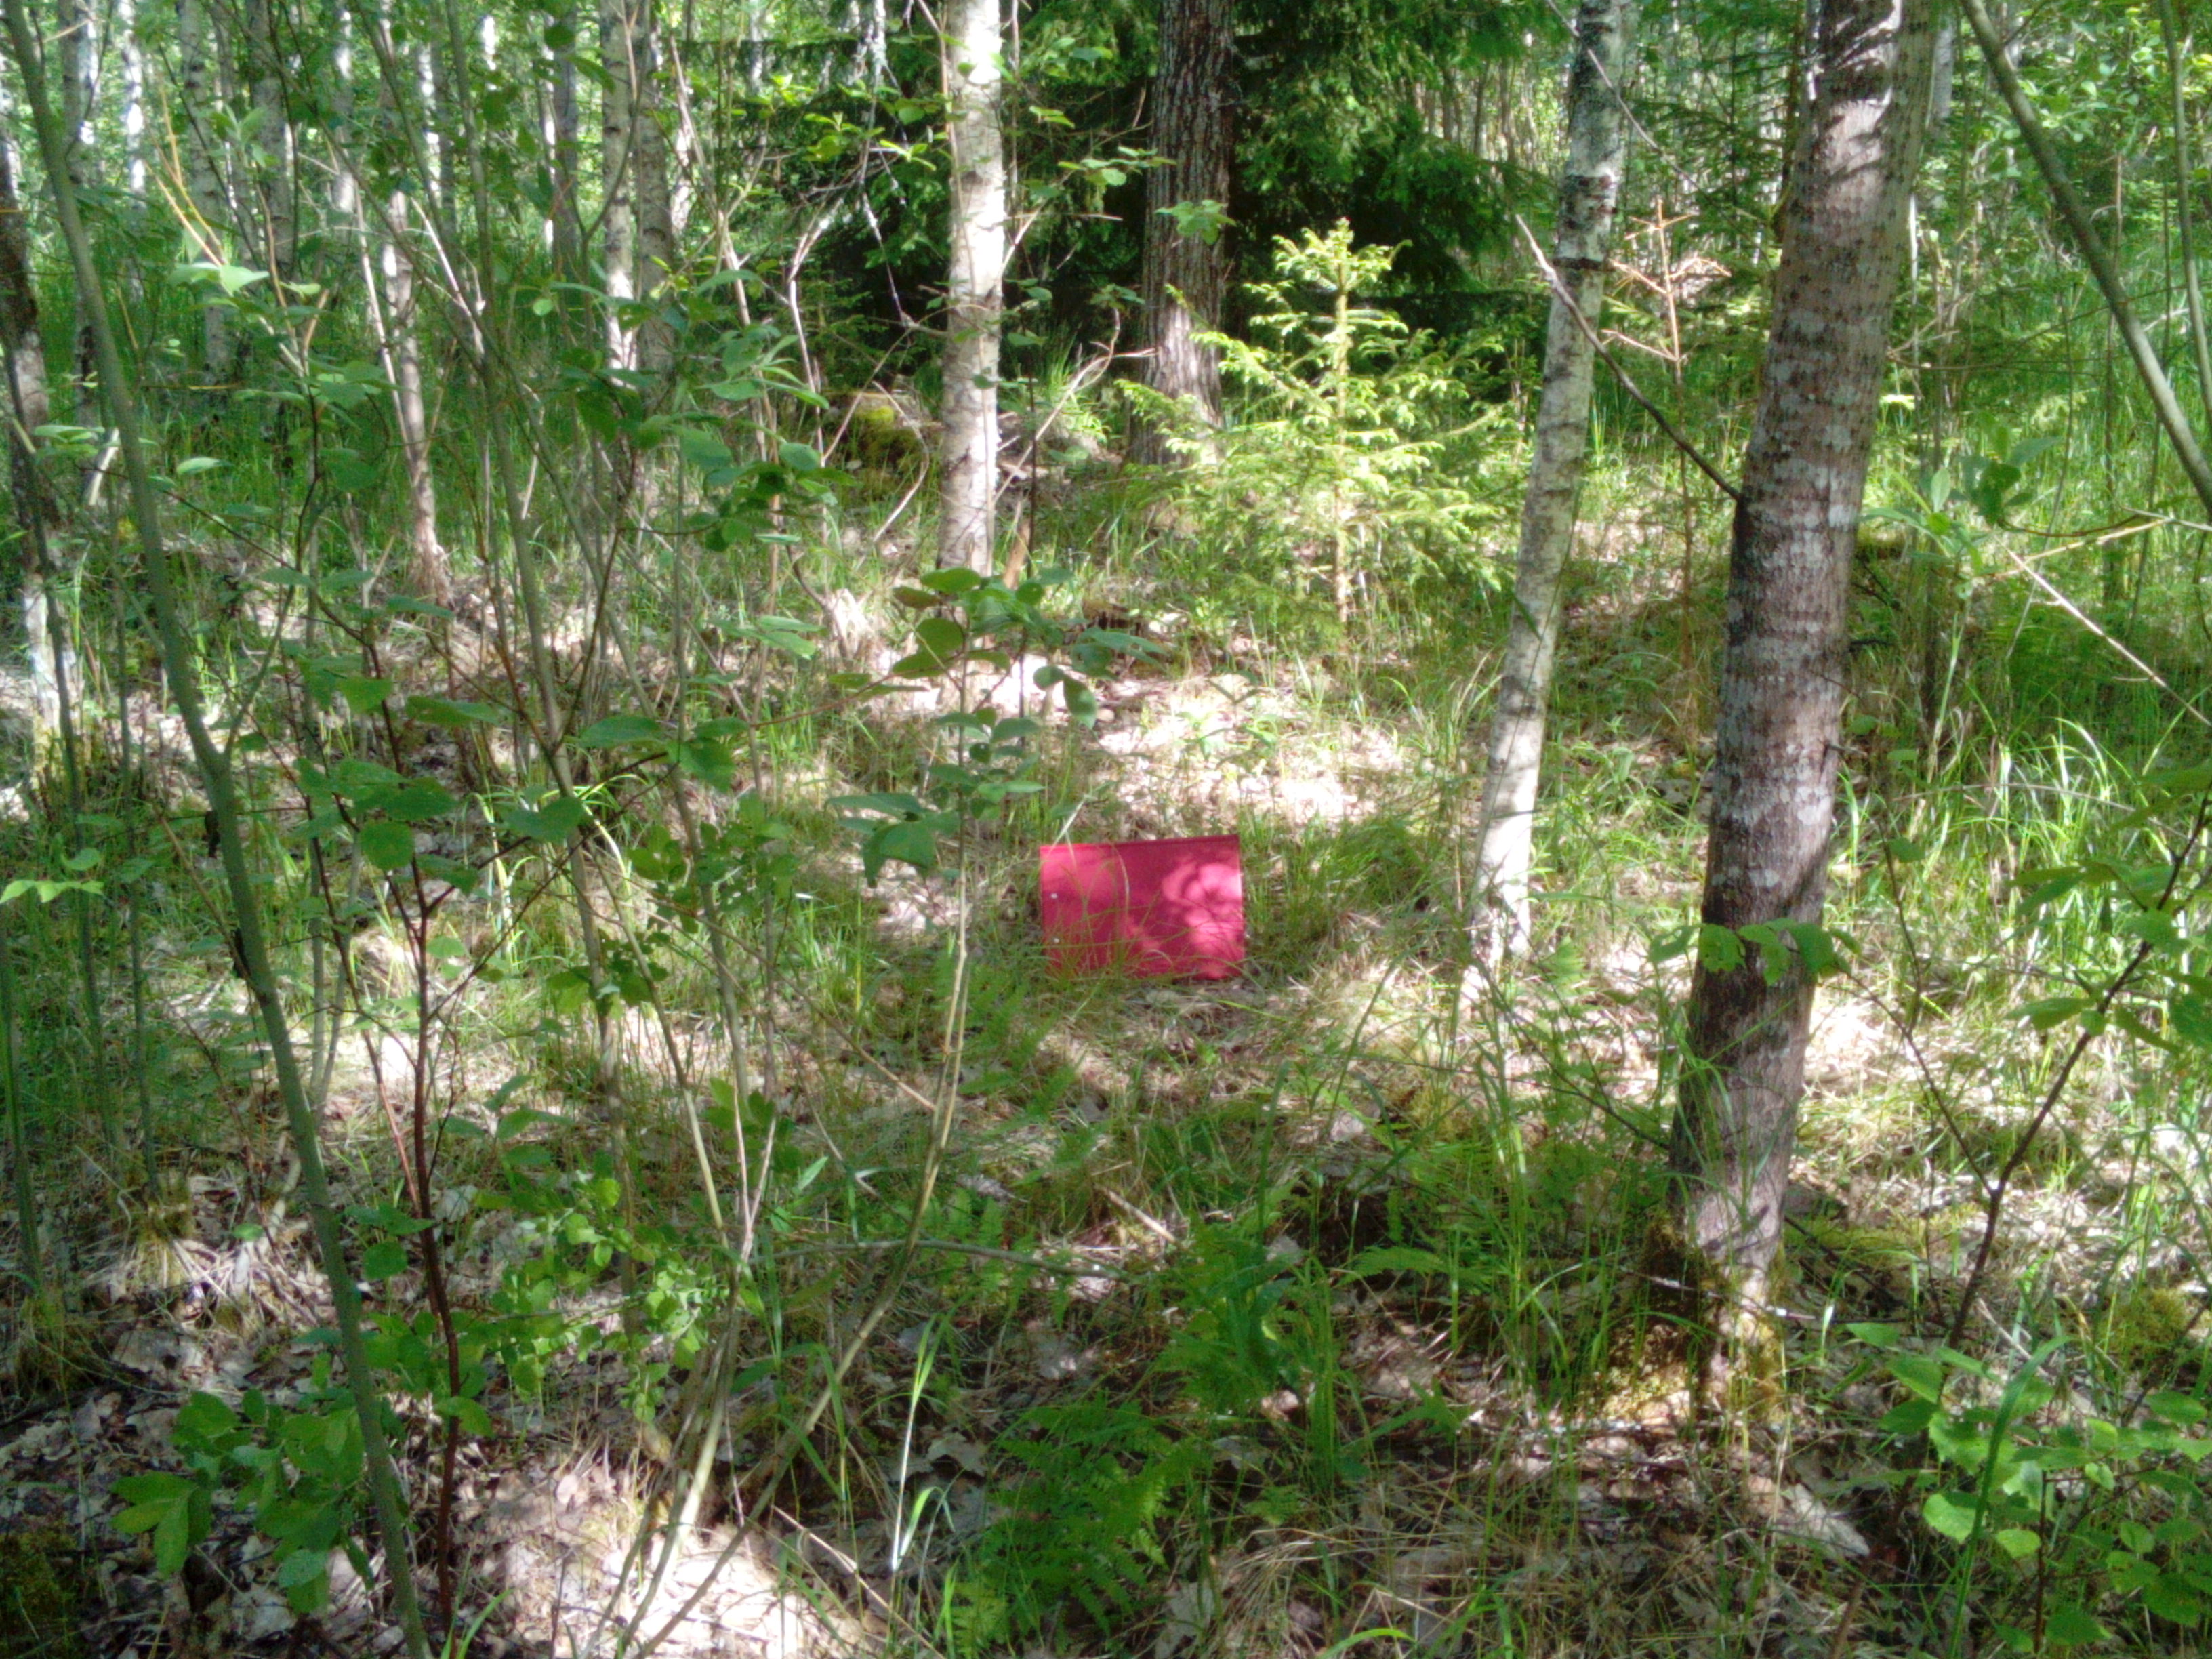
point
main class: Woodland
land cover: Broadleaved woodland
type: acidophilous oak and oak-birch forest
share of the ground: > 75 %
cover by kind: broadleaved forest trees 80 %, coniferous forest trees 15 %, herbaceous plants 5 %
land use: Forestry
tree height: > 5 m
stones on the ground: < 10 %
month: June
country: LV
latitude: 56.7086
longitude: 22.2548
